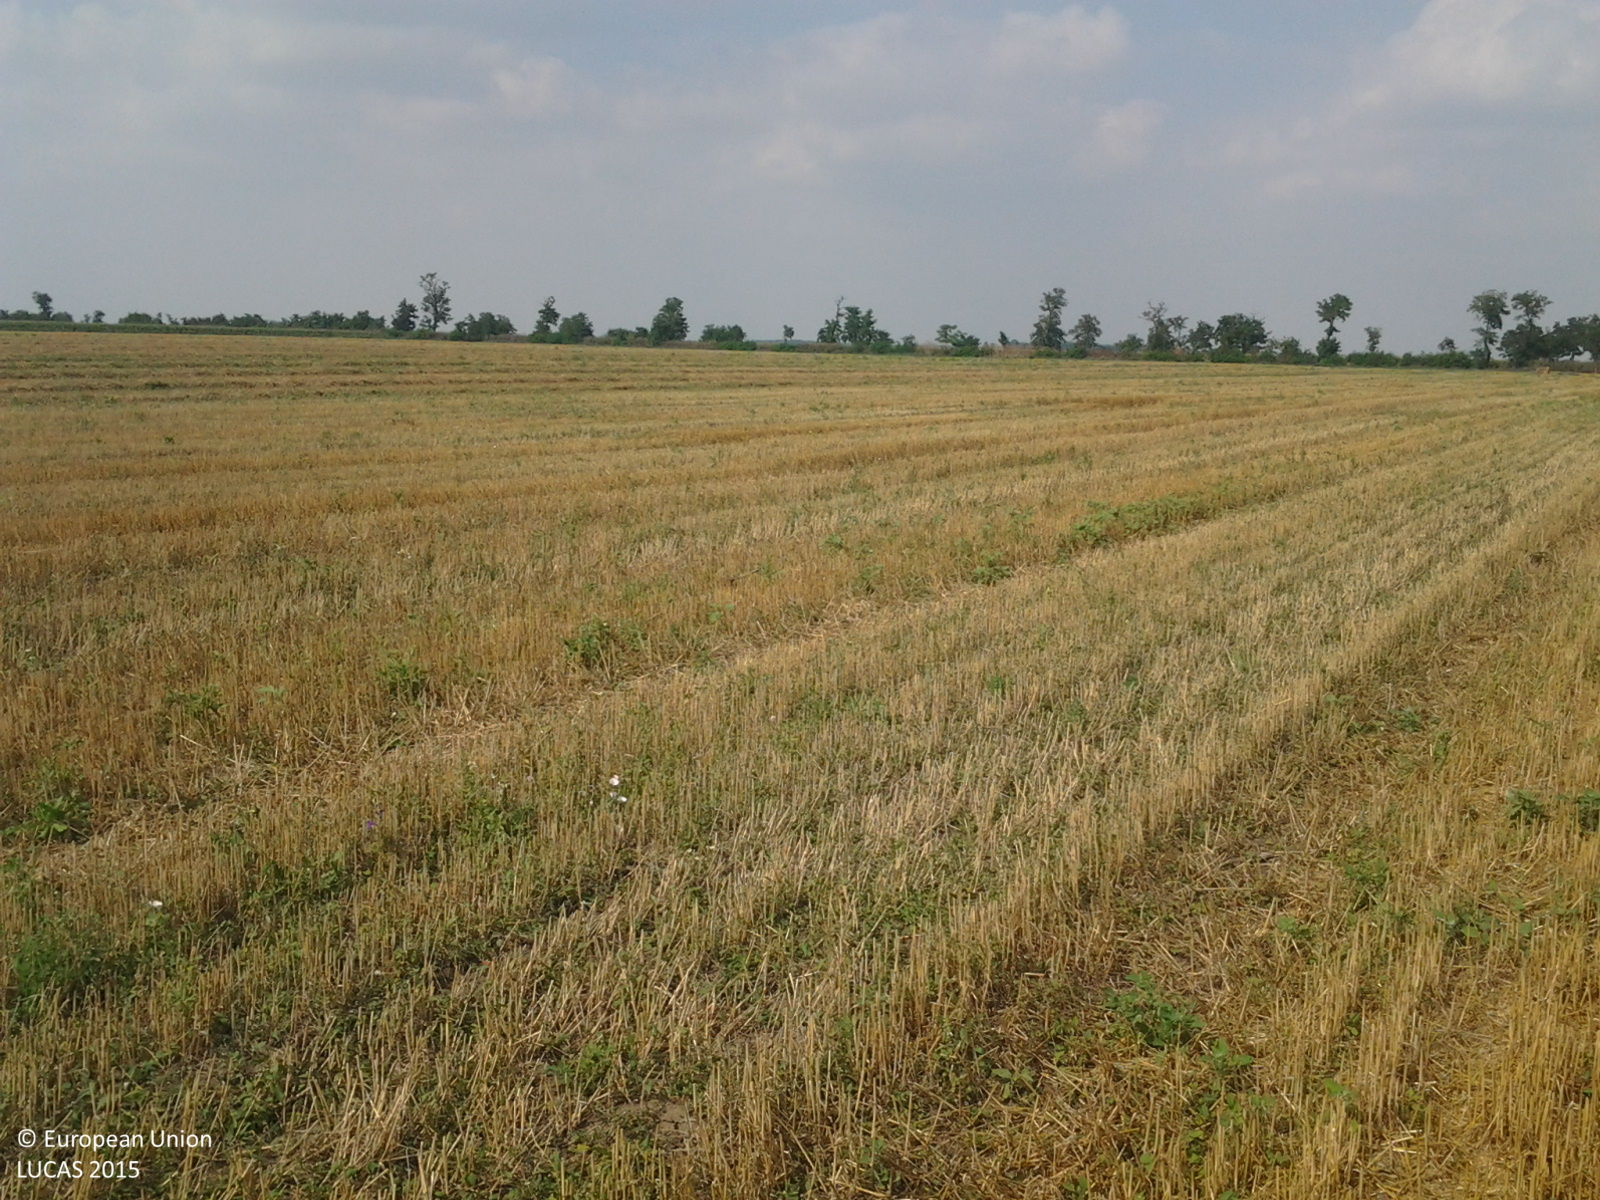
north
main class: Cropland
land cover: Common wheat
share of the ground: 10 - 25 %
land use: Agriculture (excluding fallow land and kitchen gardens)
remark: Harvested field
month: August
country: HU
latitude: 47.0472
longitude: 20.3337
